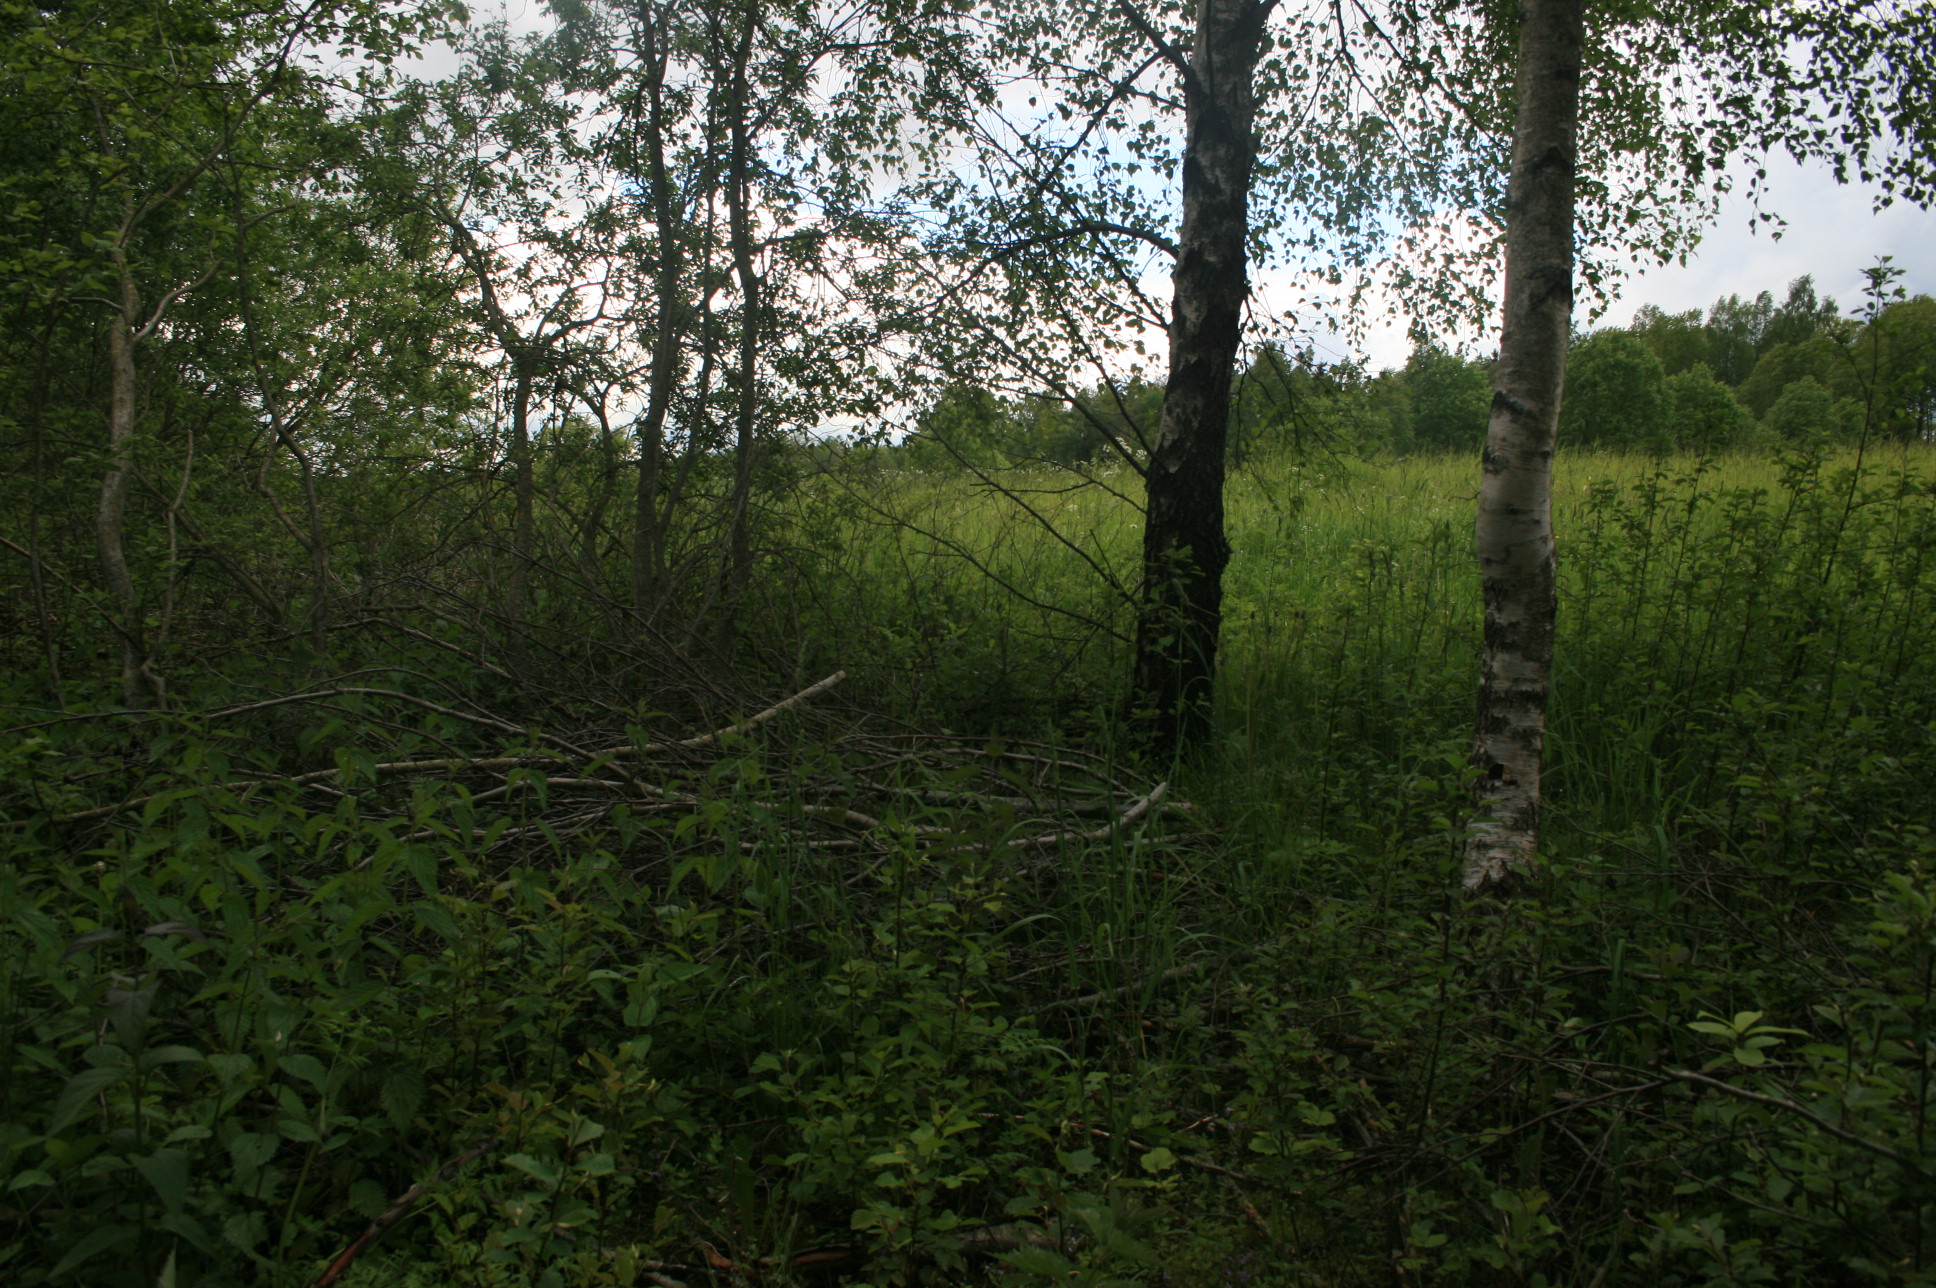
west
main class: Woodland
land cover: Broadleaved woodland
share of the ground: > 75 %
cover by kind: broadleaved forest trees 85 %, herbaceous plants 15 %
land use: Semi-natural and natural areas not in use
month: May
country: LT
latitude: 55.9485
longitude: 22.0138
